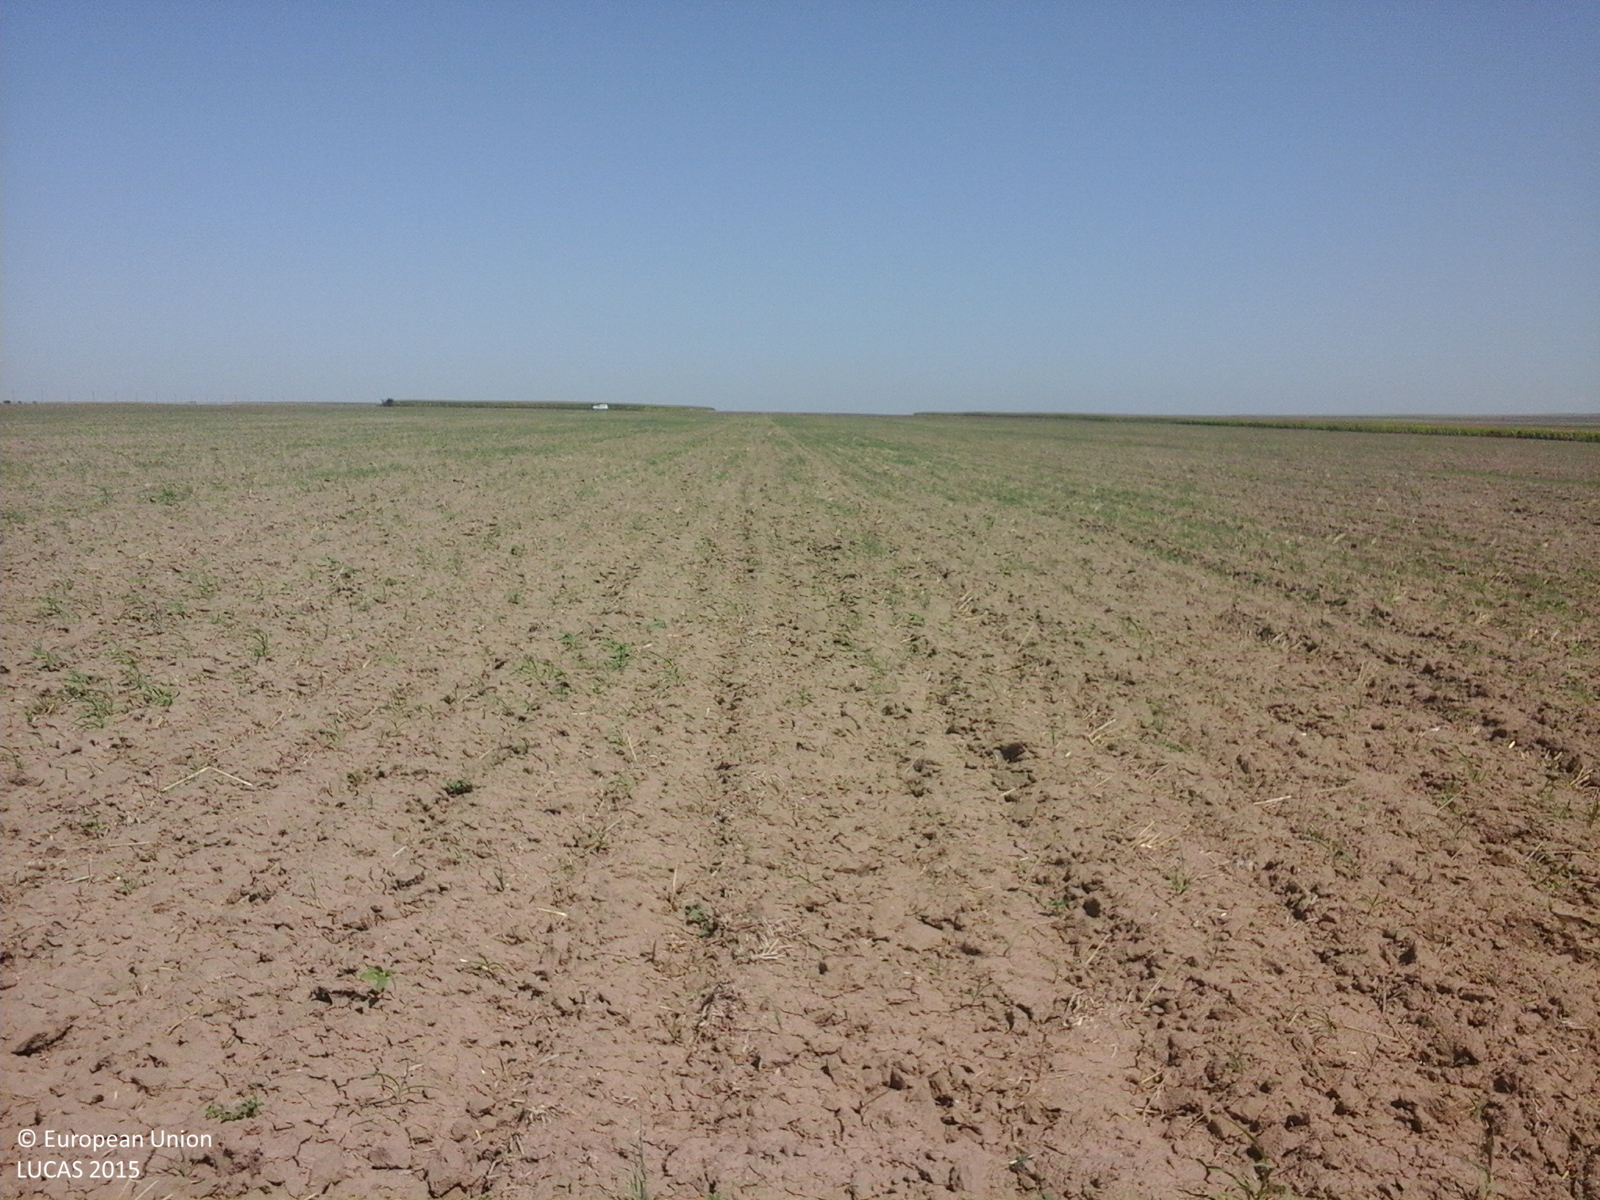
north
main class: Cropland
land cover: Durum wheat
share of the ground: < 10 %
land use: Agriculture (excluding fallow land and kitchen gardens)
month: August
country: RO
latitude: 44.5807
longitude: 28.4474
